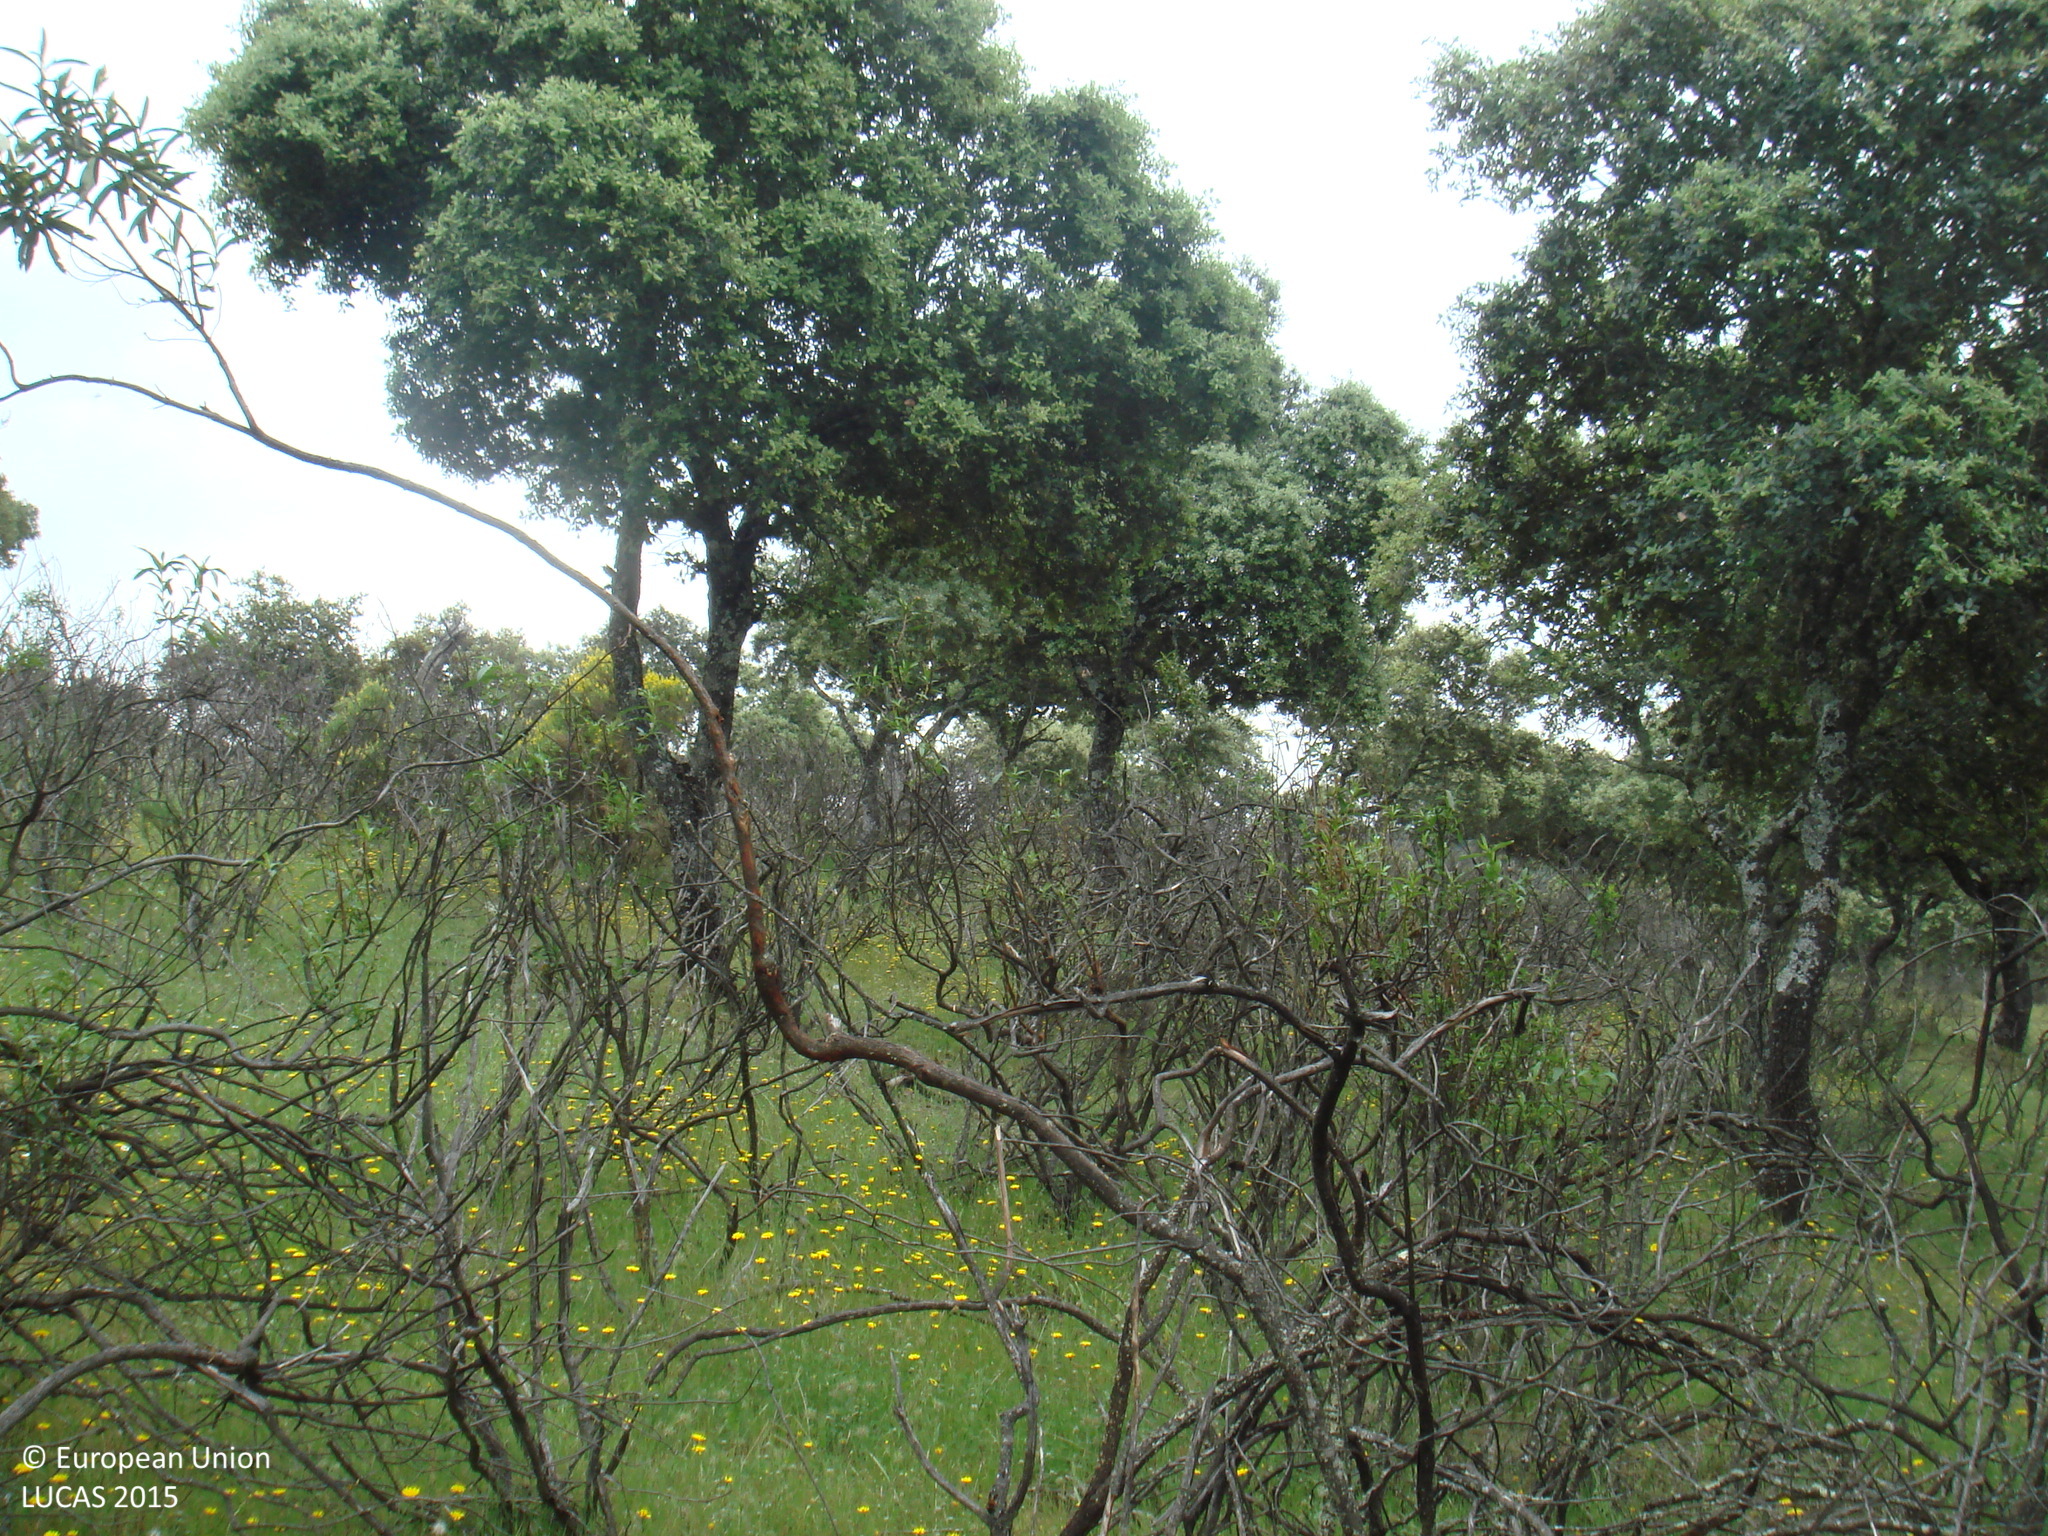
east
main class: Woodland
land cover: Broadleaved woodland
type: broadleaved evergreen forest
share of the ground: > 75 %
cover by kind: broadleaved forest trees 40 %, shrubs 40 %, herbaceous plants 20 %
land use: Forestry
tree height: > 5 m
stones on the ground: 10 - 25 %
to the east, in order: Broadleaved woodland; Shrubland with sparse tree cover; Shrubland without tree cover; Broadleaved woodland; Rivers and streams; Grassland without tree/shrub cover
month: April
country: ES
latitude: 38.1703
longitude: -4.5234
